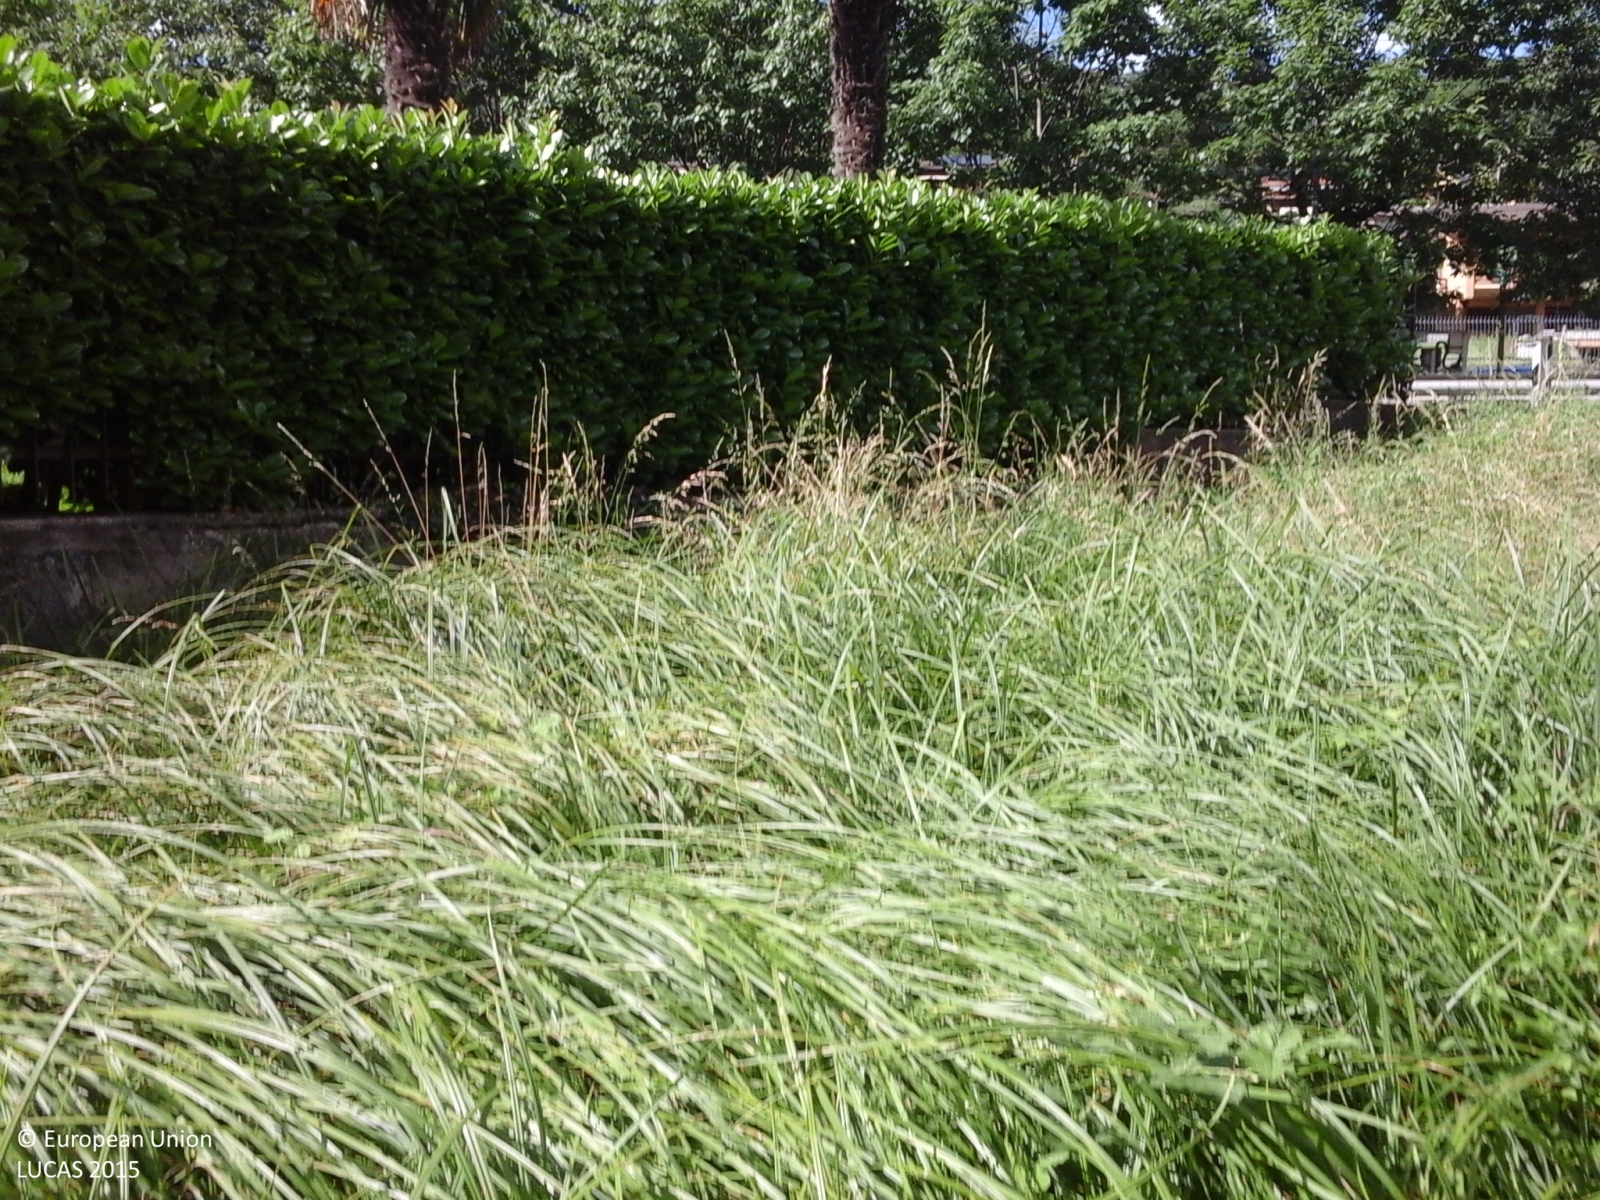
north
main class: Woodland
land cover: Broadleaved woodland
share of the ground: 50 - 75 %
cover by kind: shrubs 60 %, broadleaved forest trees 20 %, herbaceous plants 20 %
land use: Abandoned areas
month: June
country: IT
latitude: 45.8391
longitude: 8.7273
